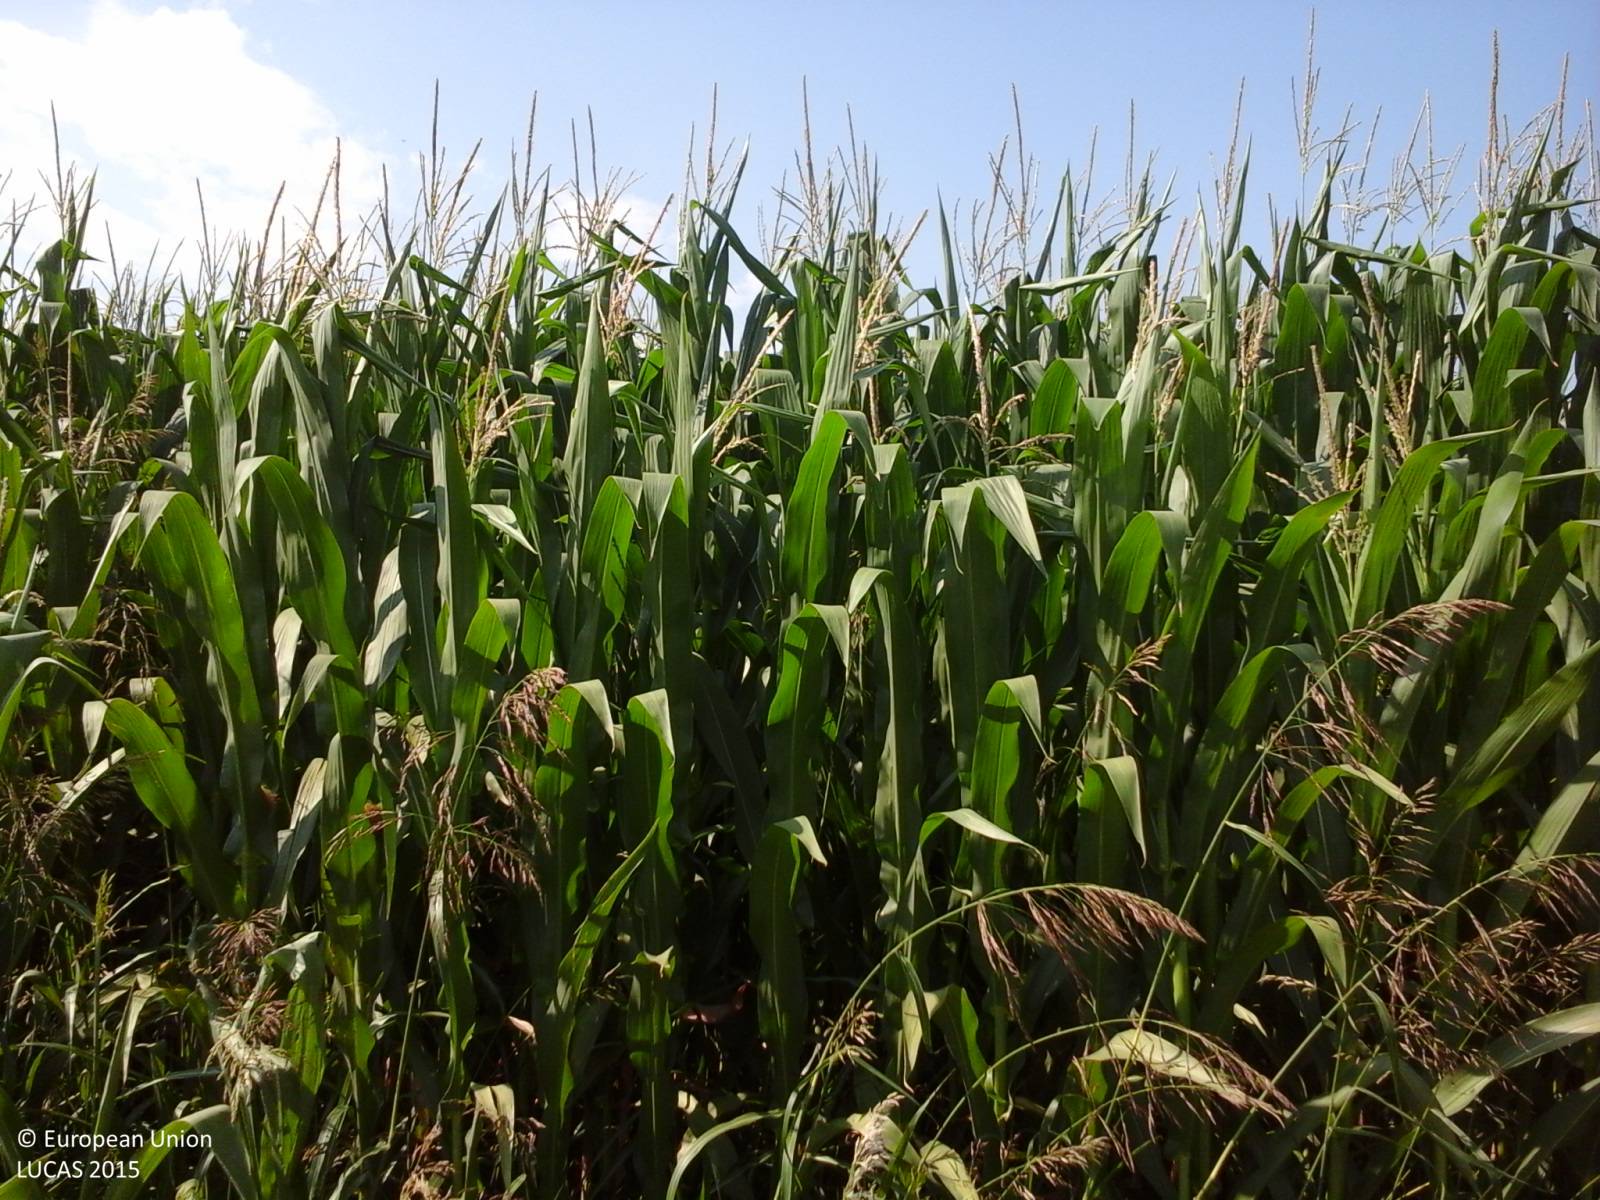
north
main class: Cropland
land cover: Maize
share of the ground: > 75 %
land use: Agriculture (excluding fallow land and kitchen gardens)
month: July
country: IT
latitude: 41.0316
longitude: 14.1343
